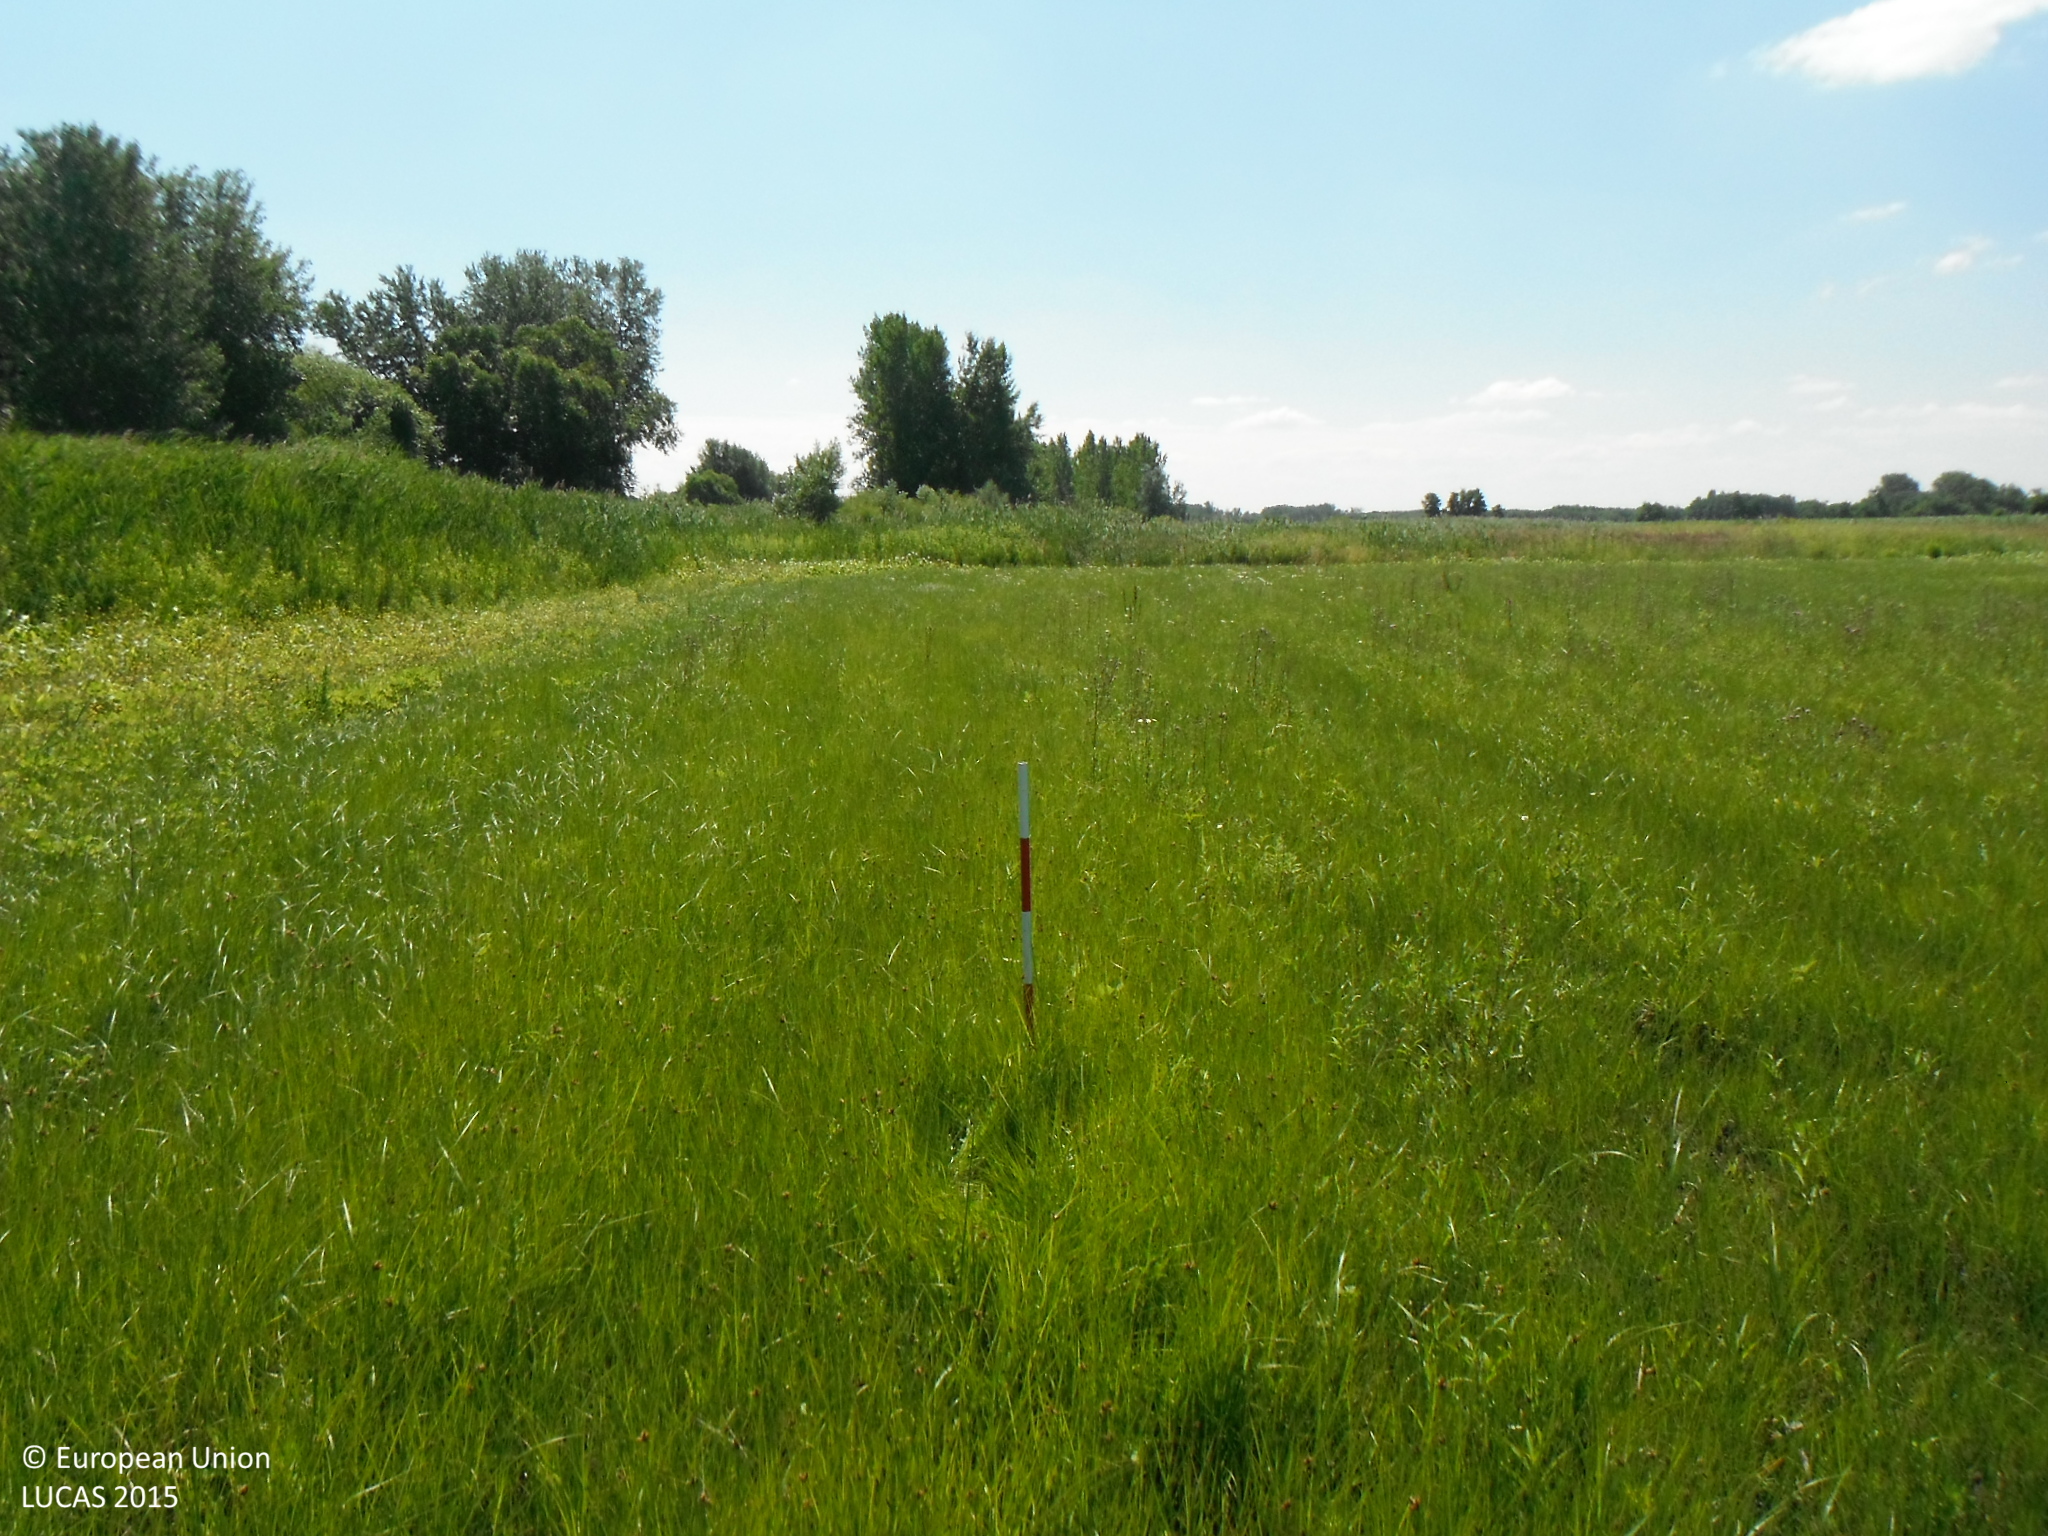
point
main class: Grassland
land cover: Spontaneously vegetated surfaces
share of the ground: > 75 %
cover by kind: herbaceous plants 100 %
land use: Fallow land
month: June
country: SK
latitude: 47.8272
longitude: 18.2016
